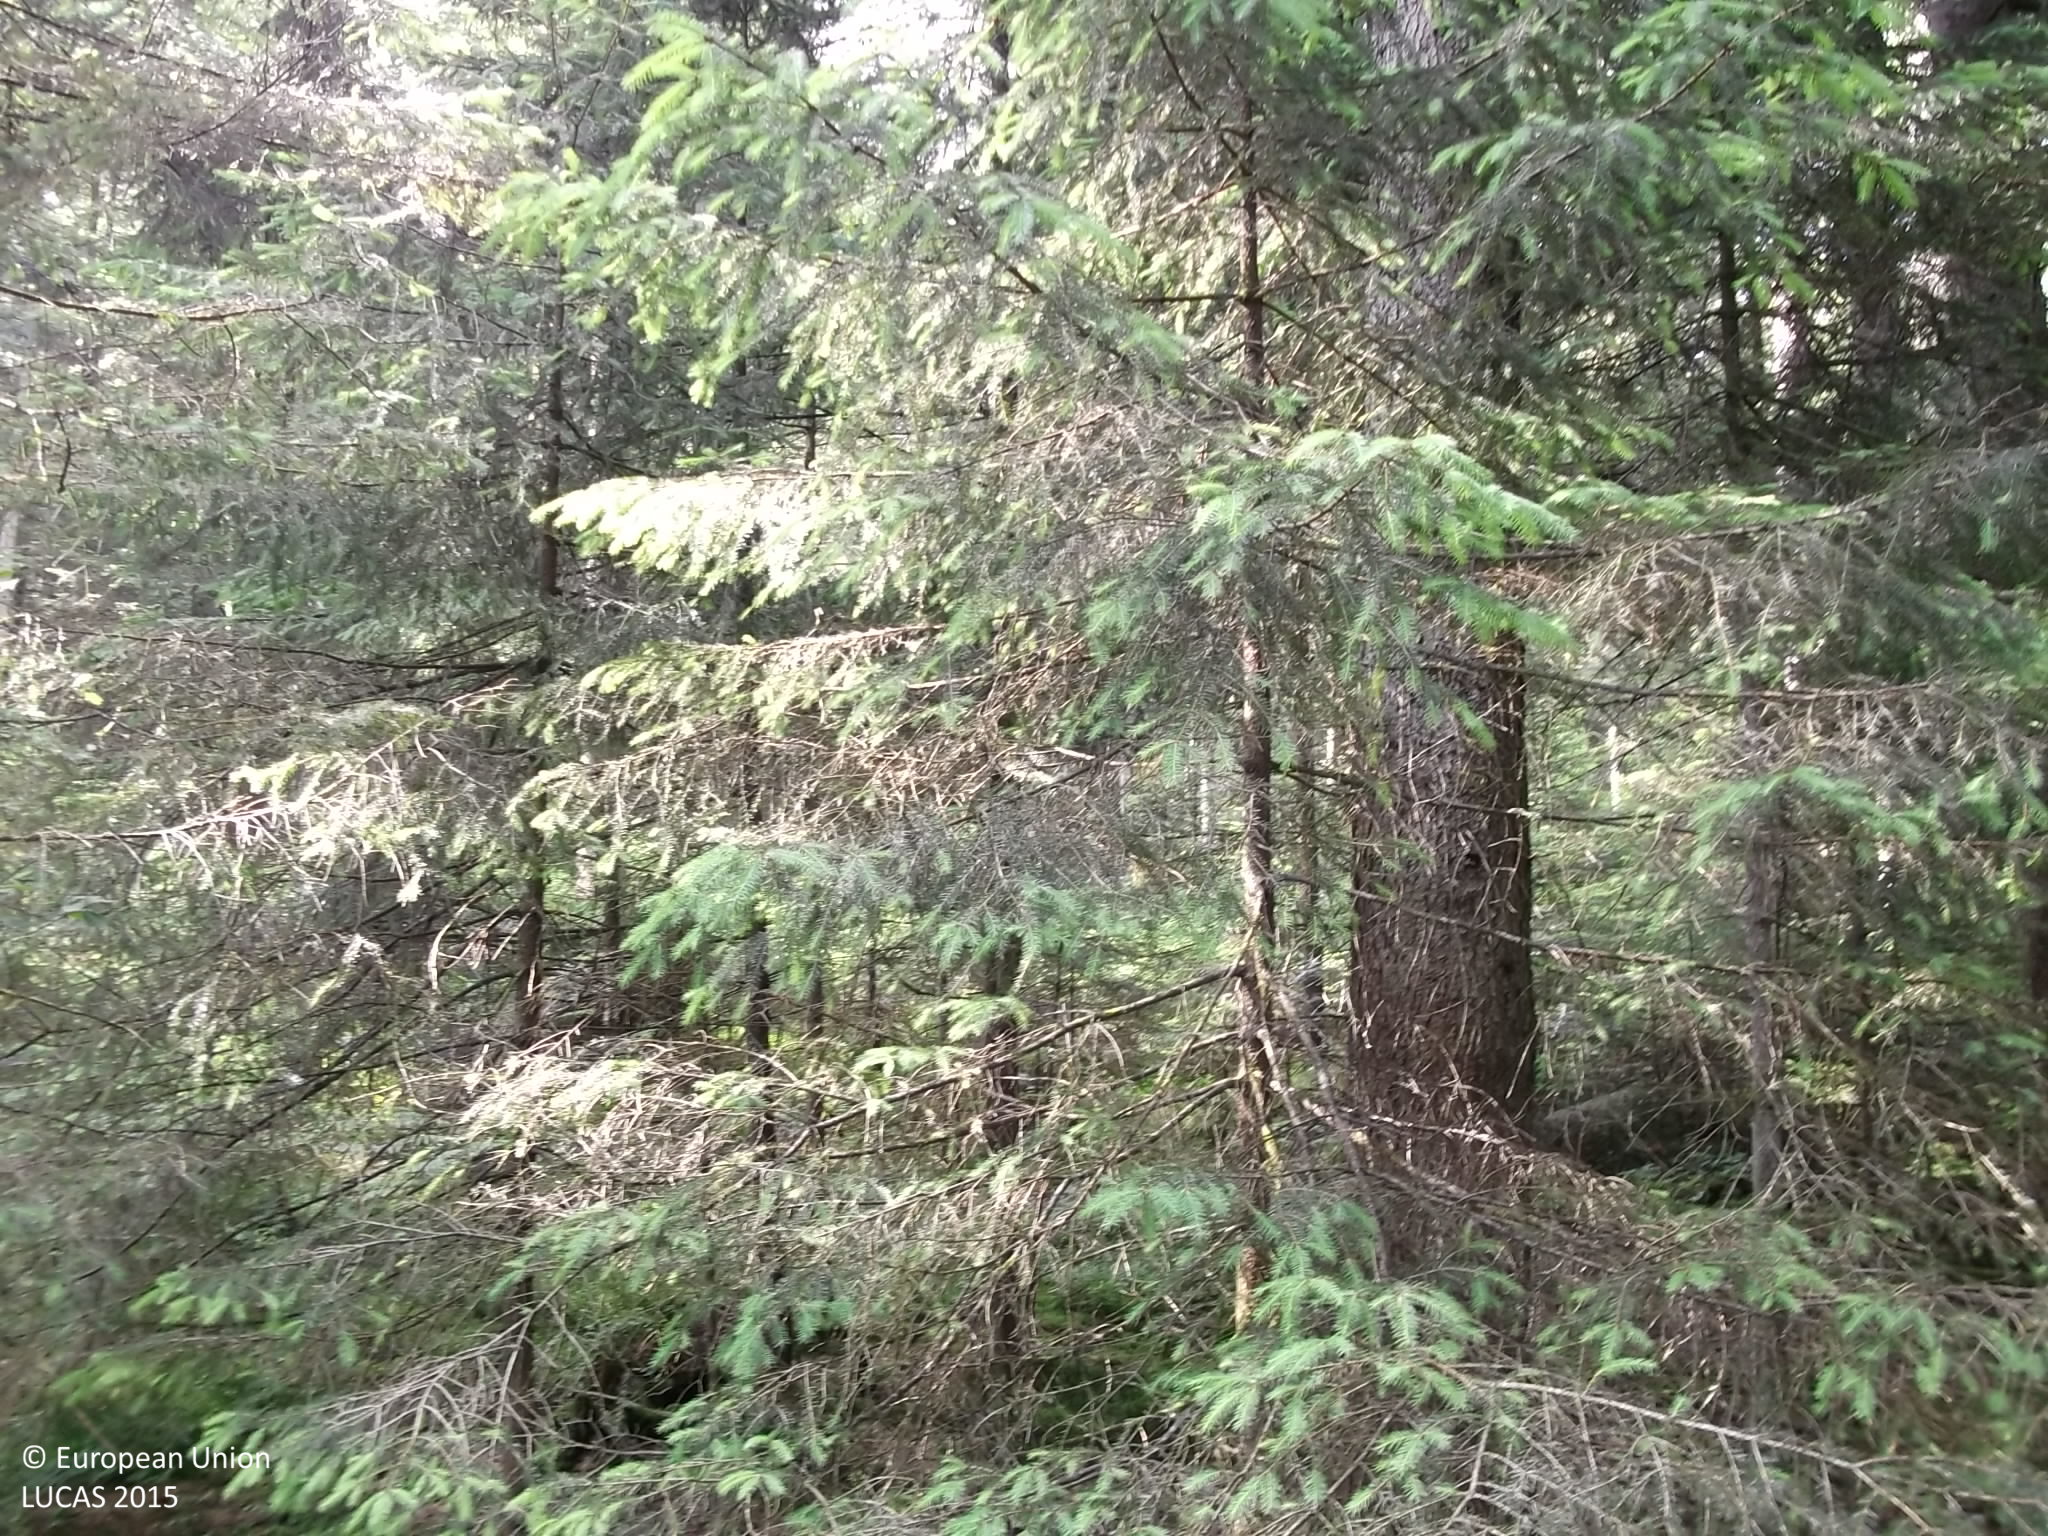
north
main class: Woodland
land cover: Spruce dominated coniferous woodland
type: alpine coniferous forest
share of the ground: > 75 %
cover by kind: coniferous forest trees 75 %, herbaceous plants 20 %, broadleaved forest trees 5 %
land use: Forestry
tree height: > 5 m
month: June
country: AT
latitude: 48.0093
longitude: 13.3904
